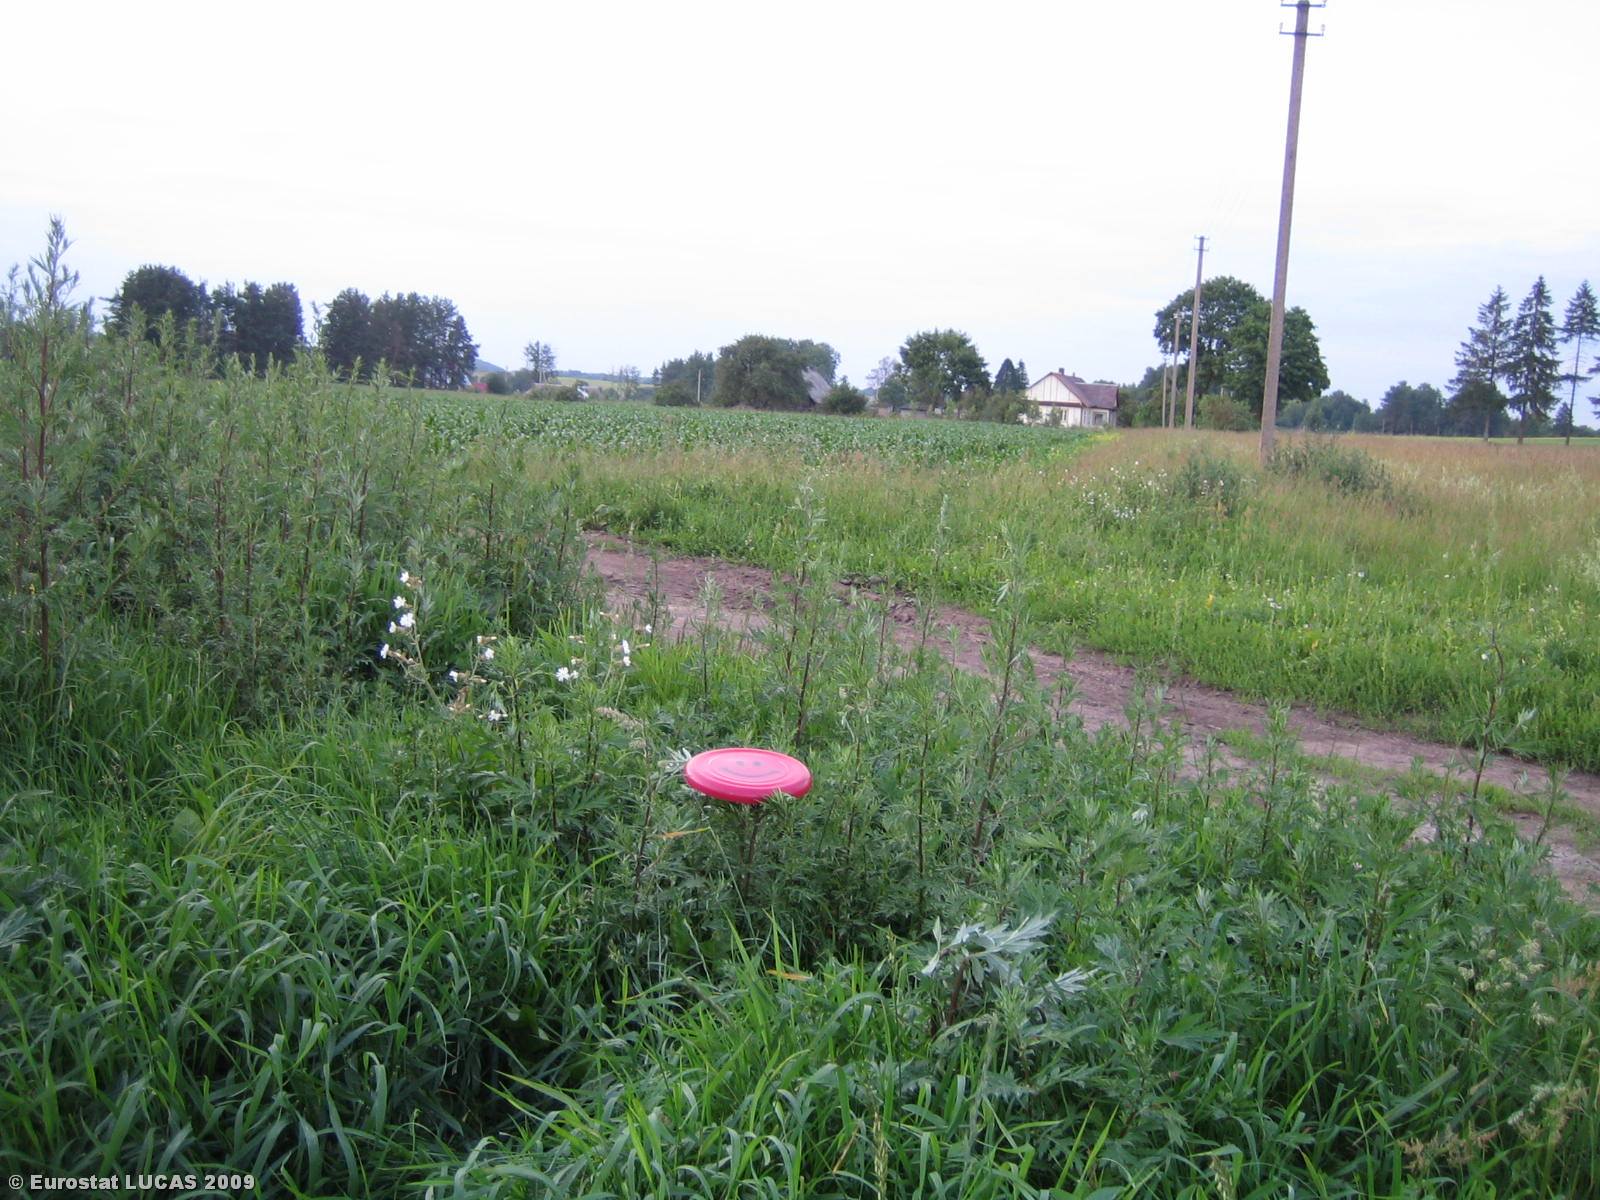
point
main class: Grassland
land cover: Grassland without tree/shrub cover
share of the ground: > 75 %
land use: Agriculture (excluding fallow land and kitchen gardens)
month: July
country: LT
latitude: 55.6486
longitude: 25.5877
